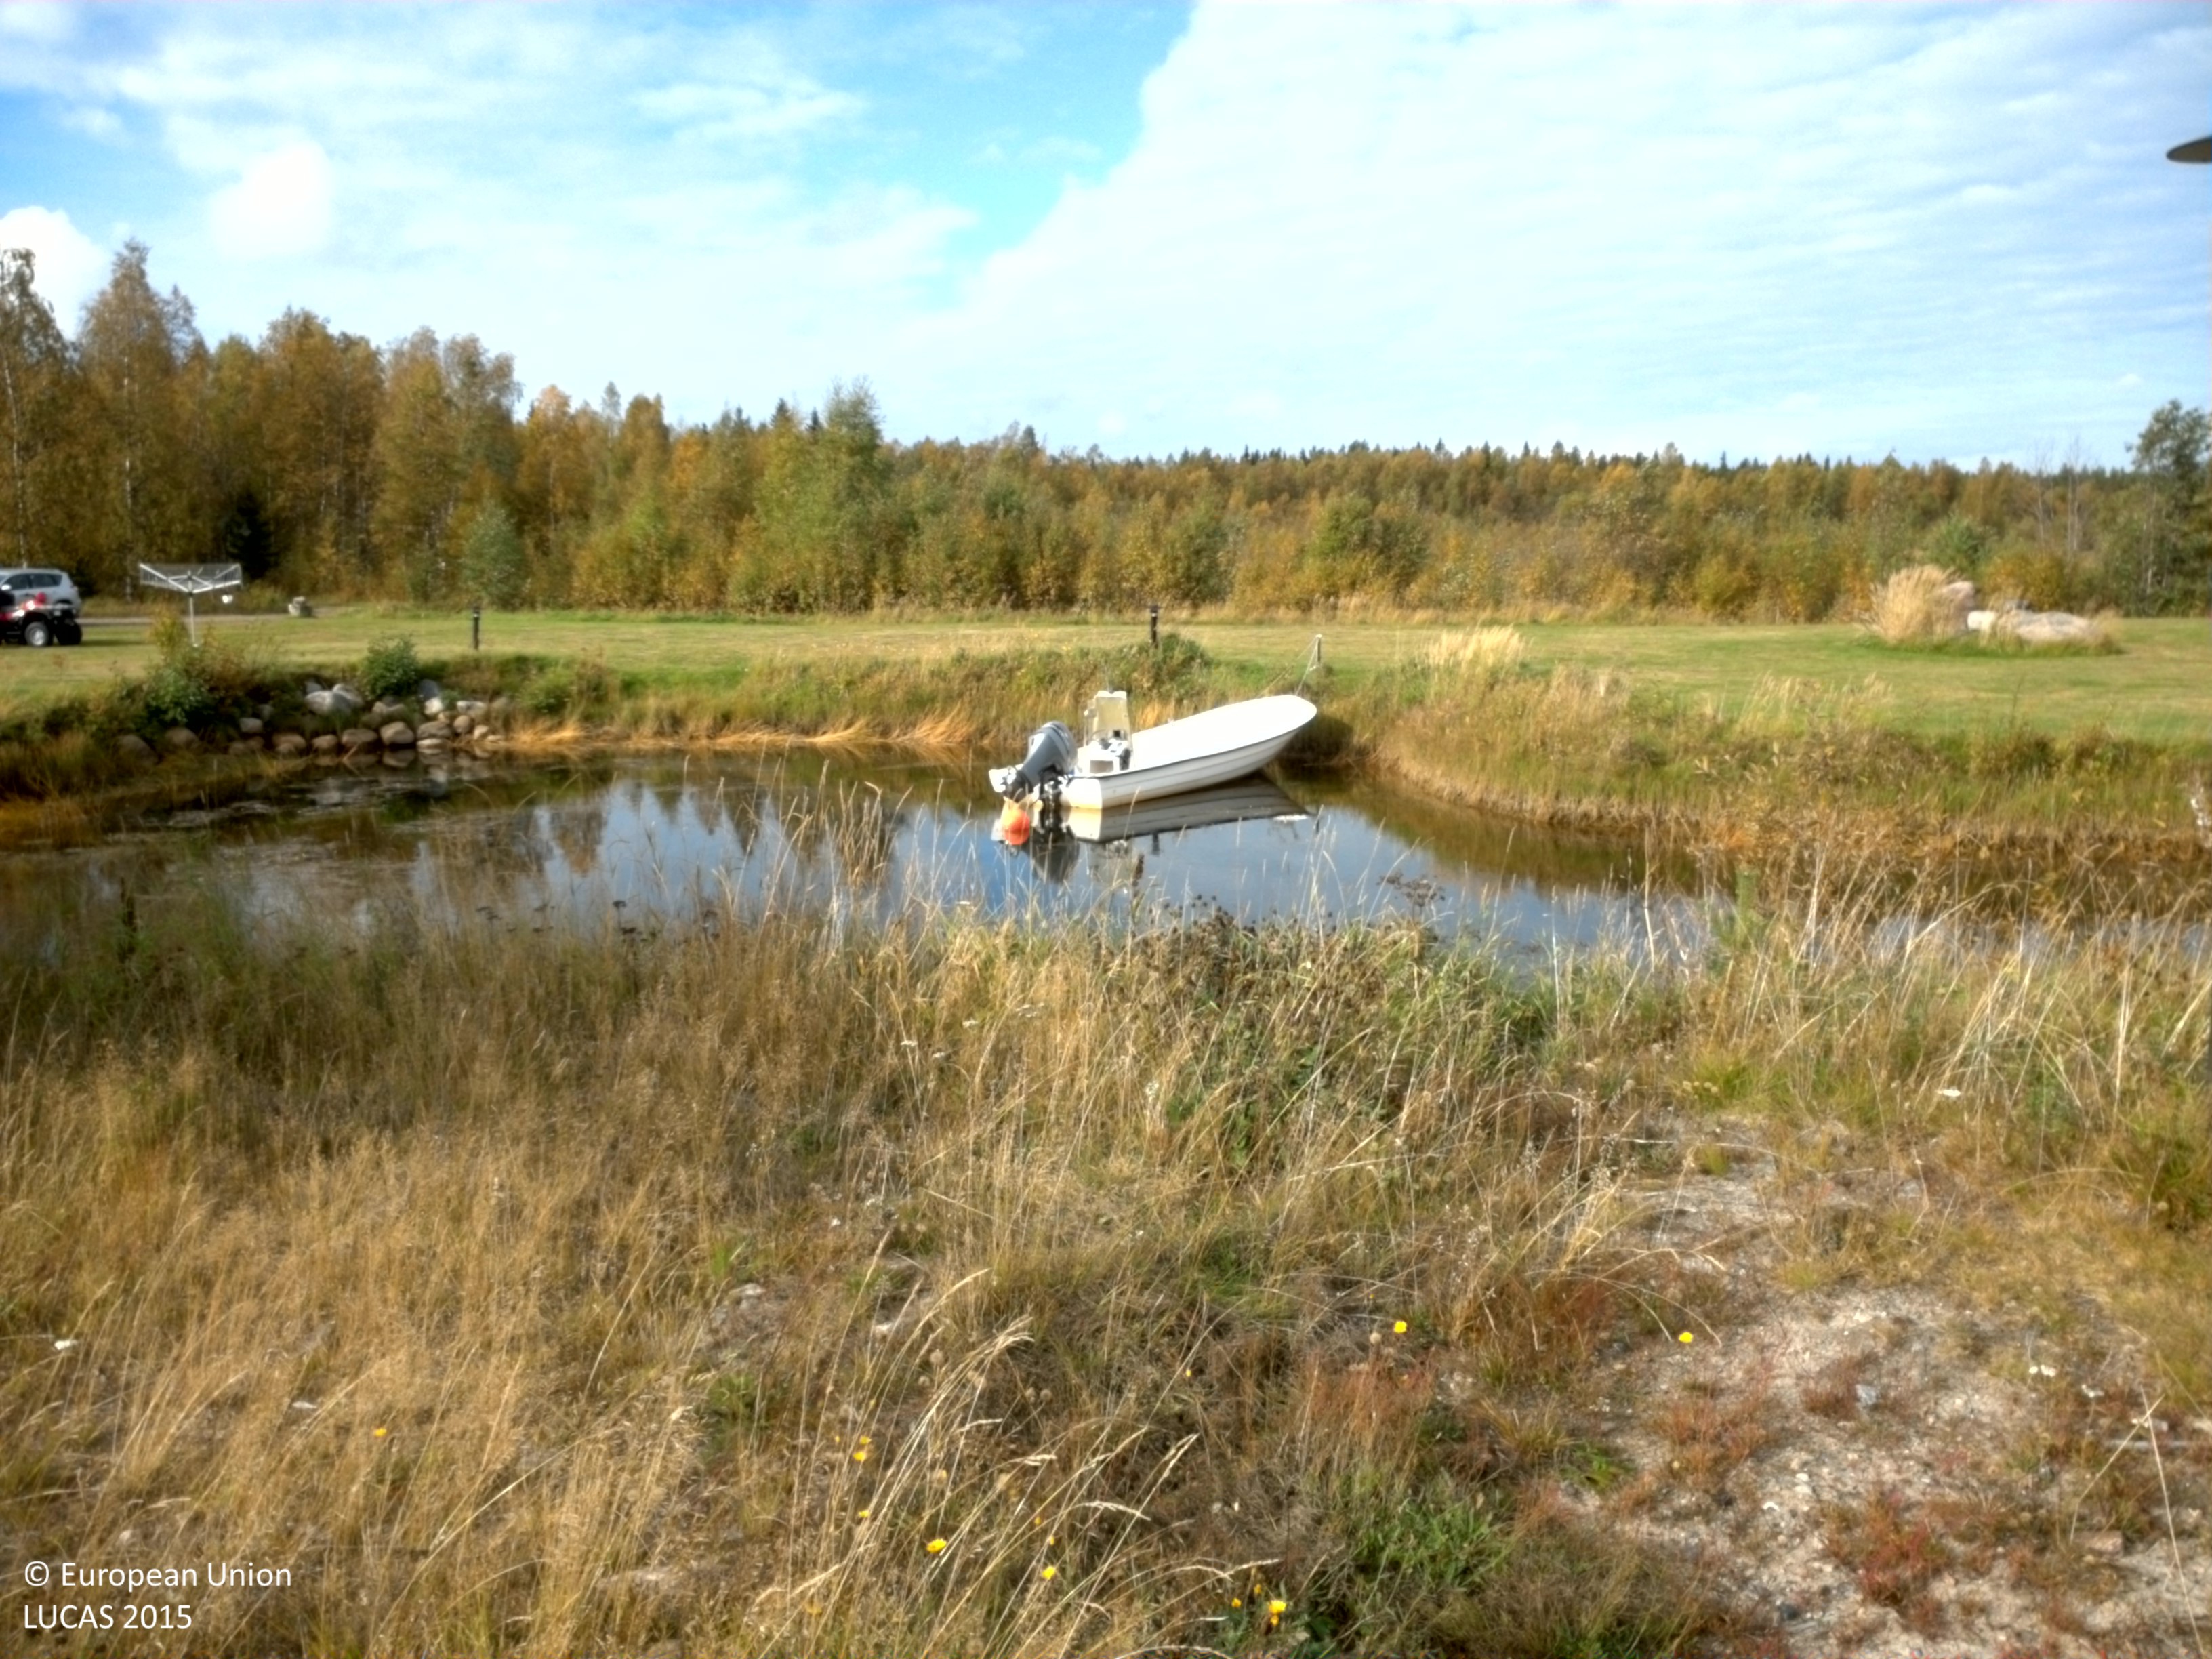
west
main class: Grassland
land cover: Grassland without tree/shrub cover
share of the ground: > 75 %
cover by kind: herbaceous plants 100 %
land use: Residential
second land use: Amenities, museums, leisure
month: September
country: SE
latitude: 65.4325
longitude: 21.8991
